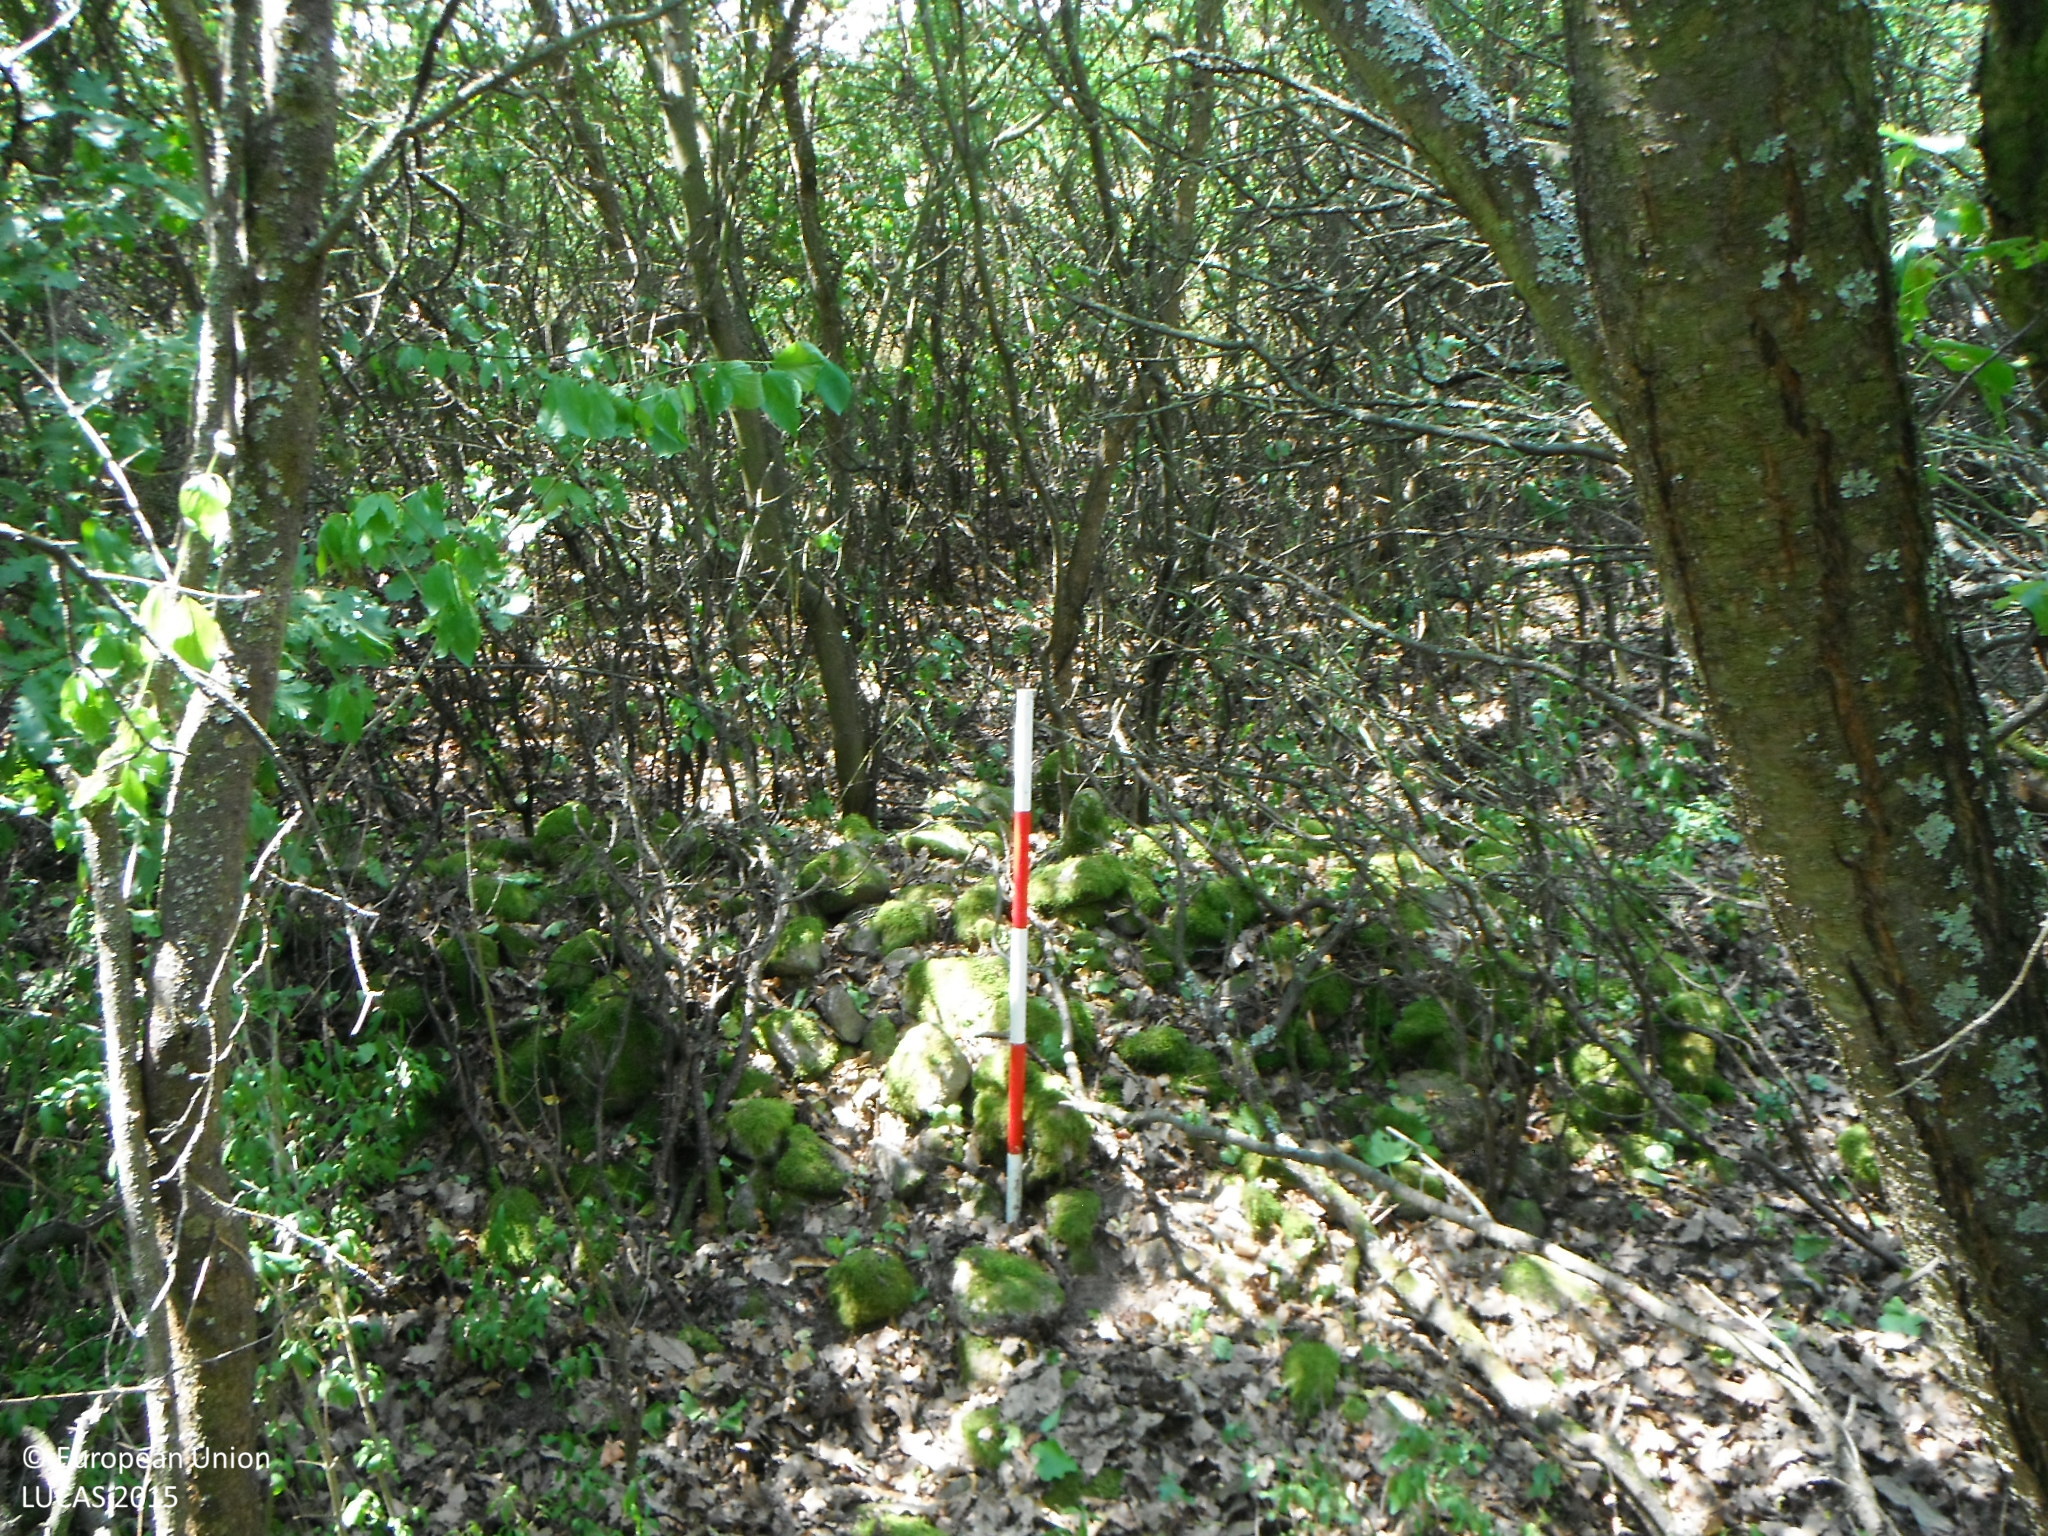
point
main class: Woodland
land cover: Broadleaved woodland
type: thermophilous deciduous forest
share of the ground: > 75 %
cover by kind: broadleaved forest trees 90 %, shrubs 10 %
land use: Forestry
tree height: > 5 m
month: July
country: SK
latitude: 48.2193
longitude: 18.9703
